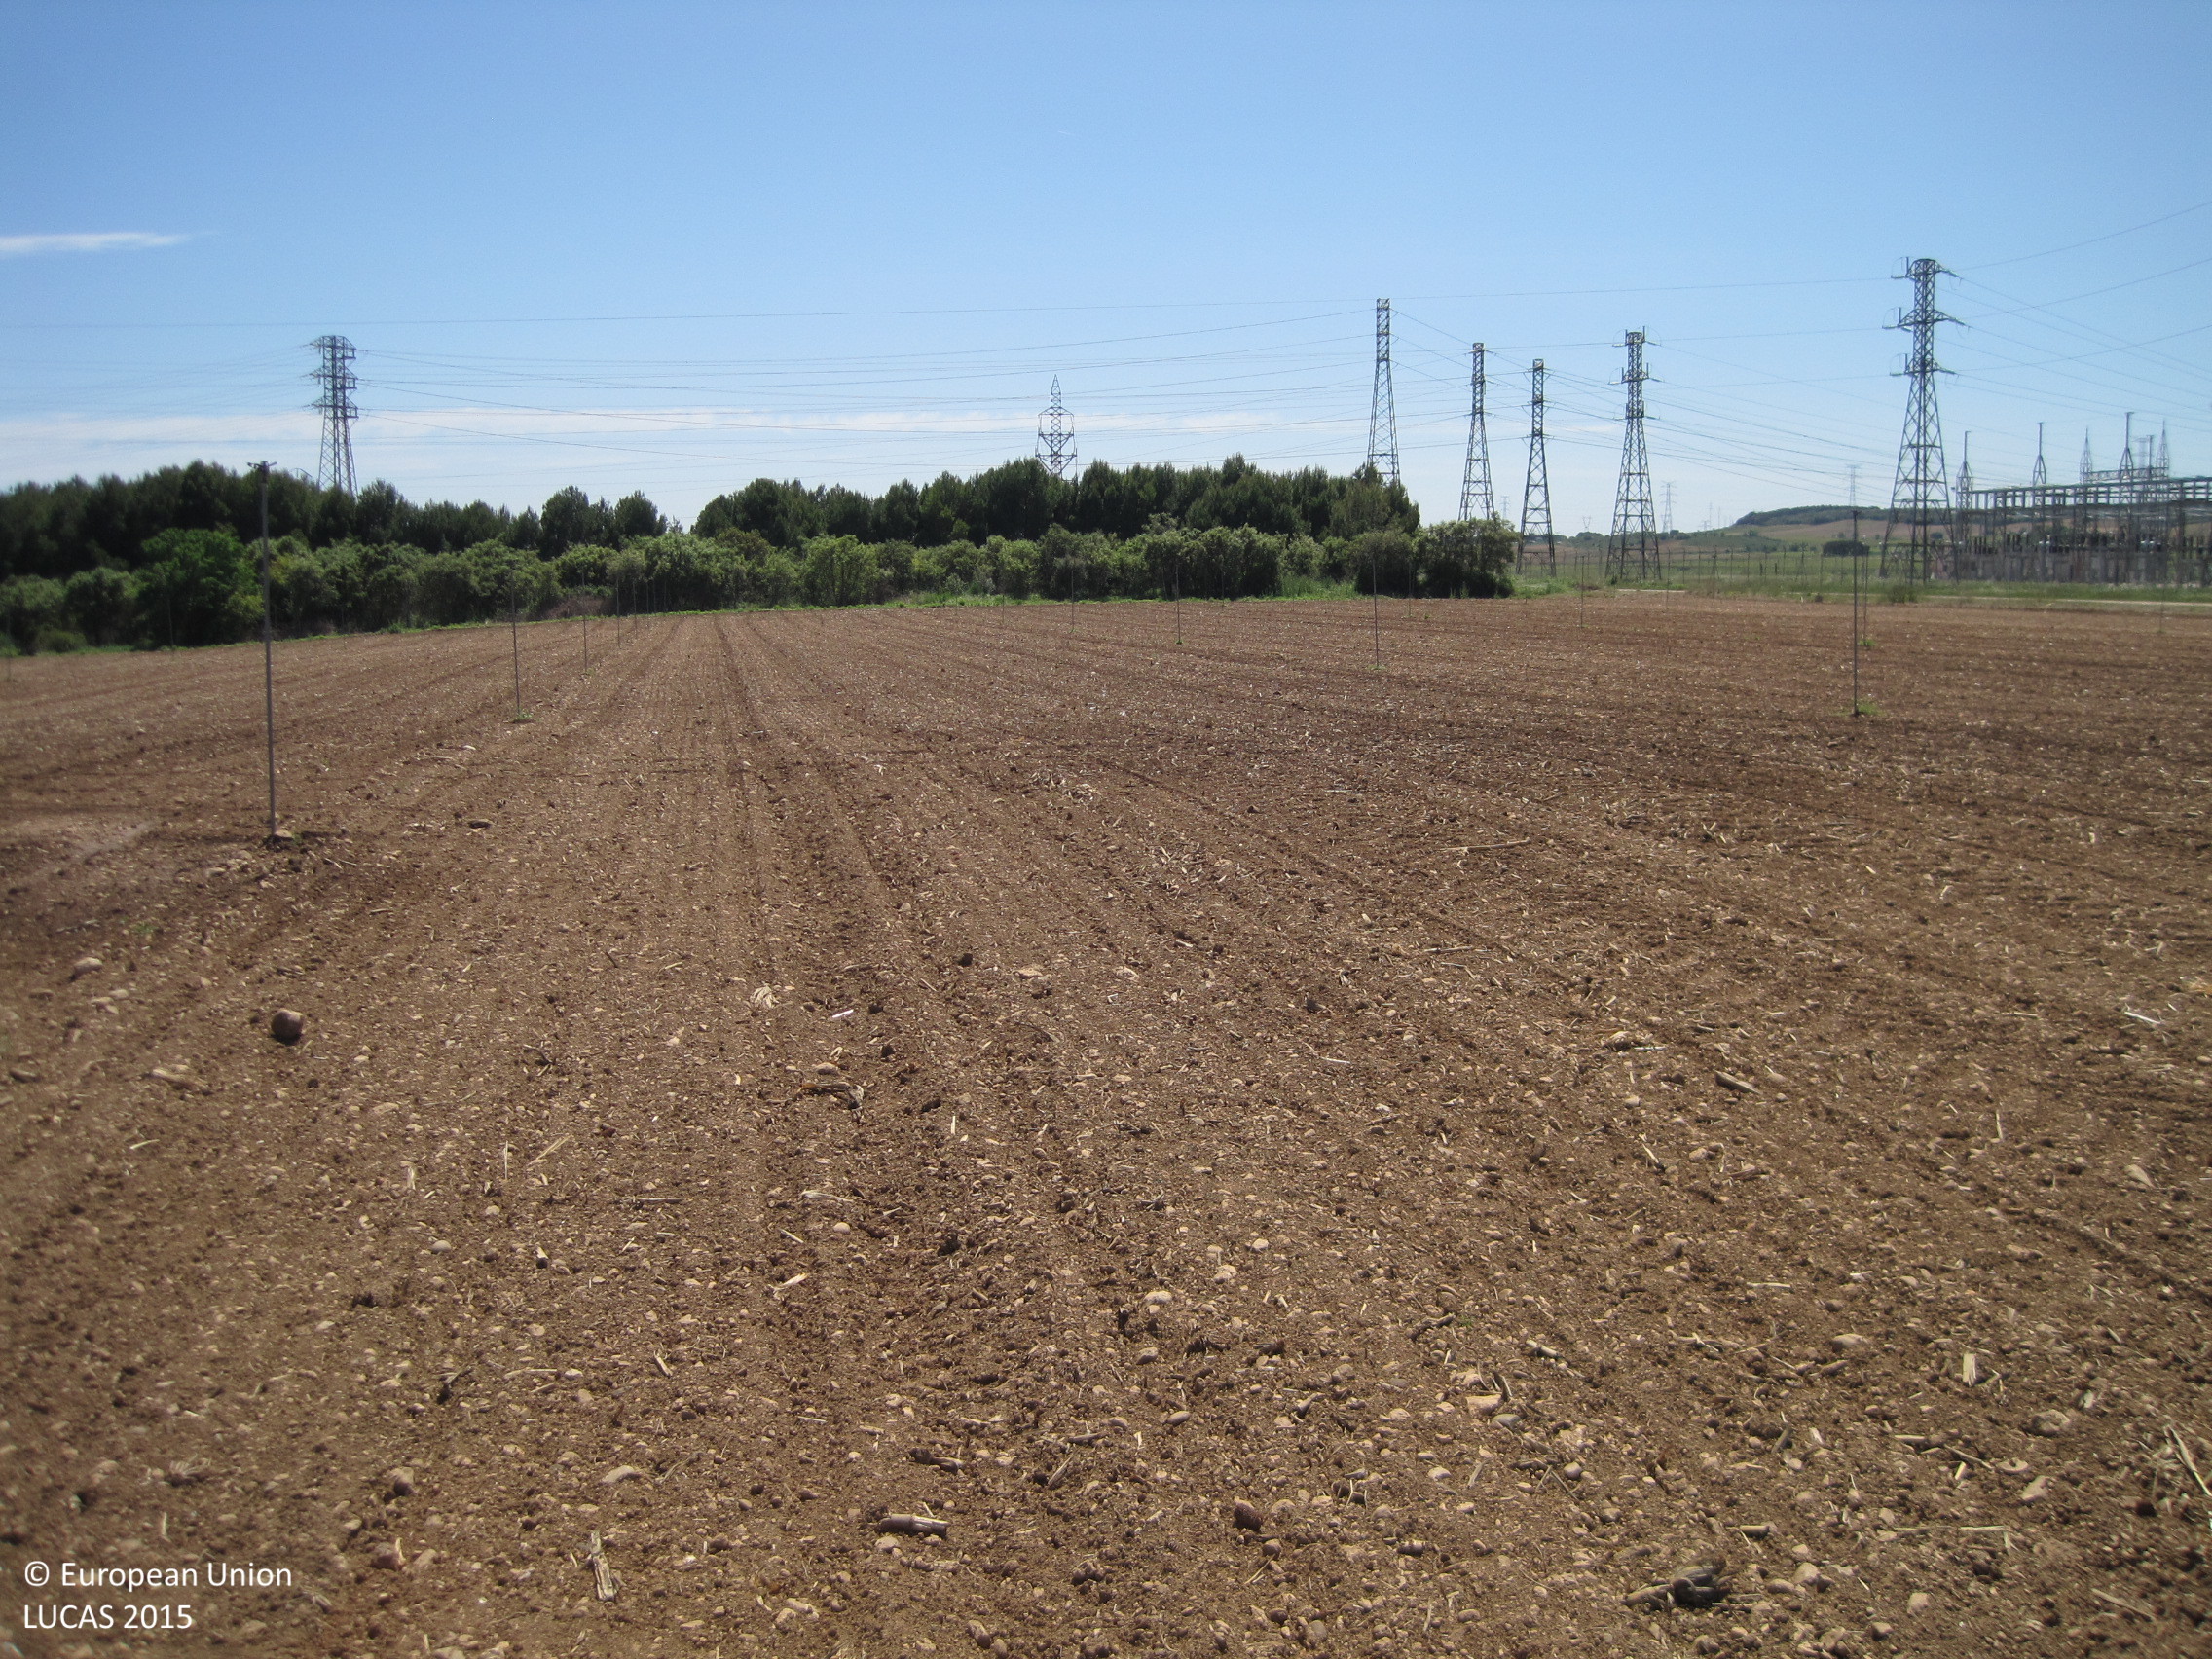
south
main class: Cropland
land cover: Maize
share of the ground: < 10 %
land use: Agriculture (excluding fallow land and kitchen gardens)
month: May
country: ES
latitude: 42.5041
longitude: -1.6827
